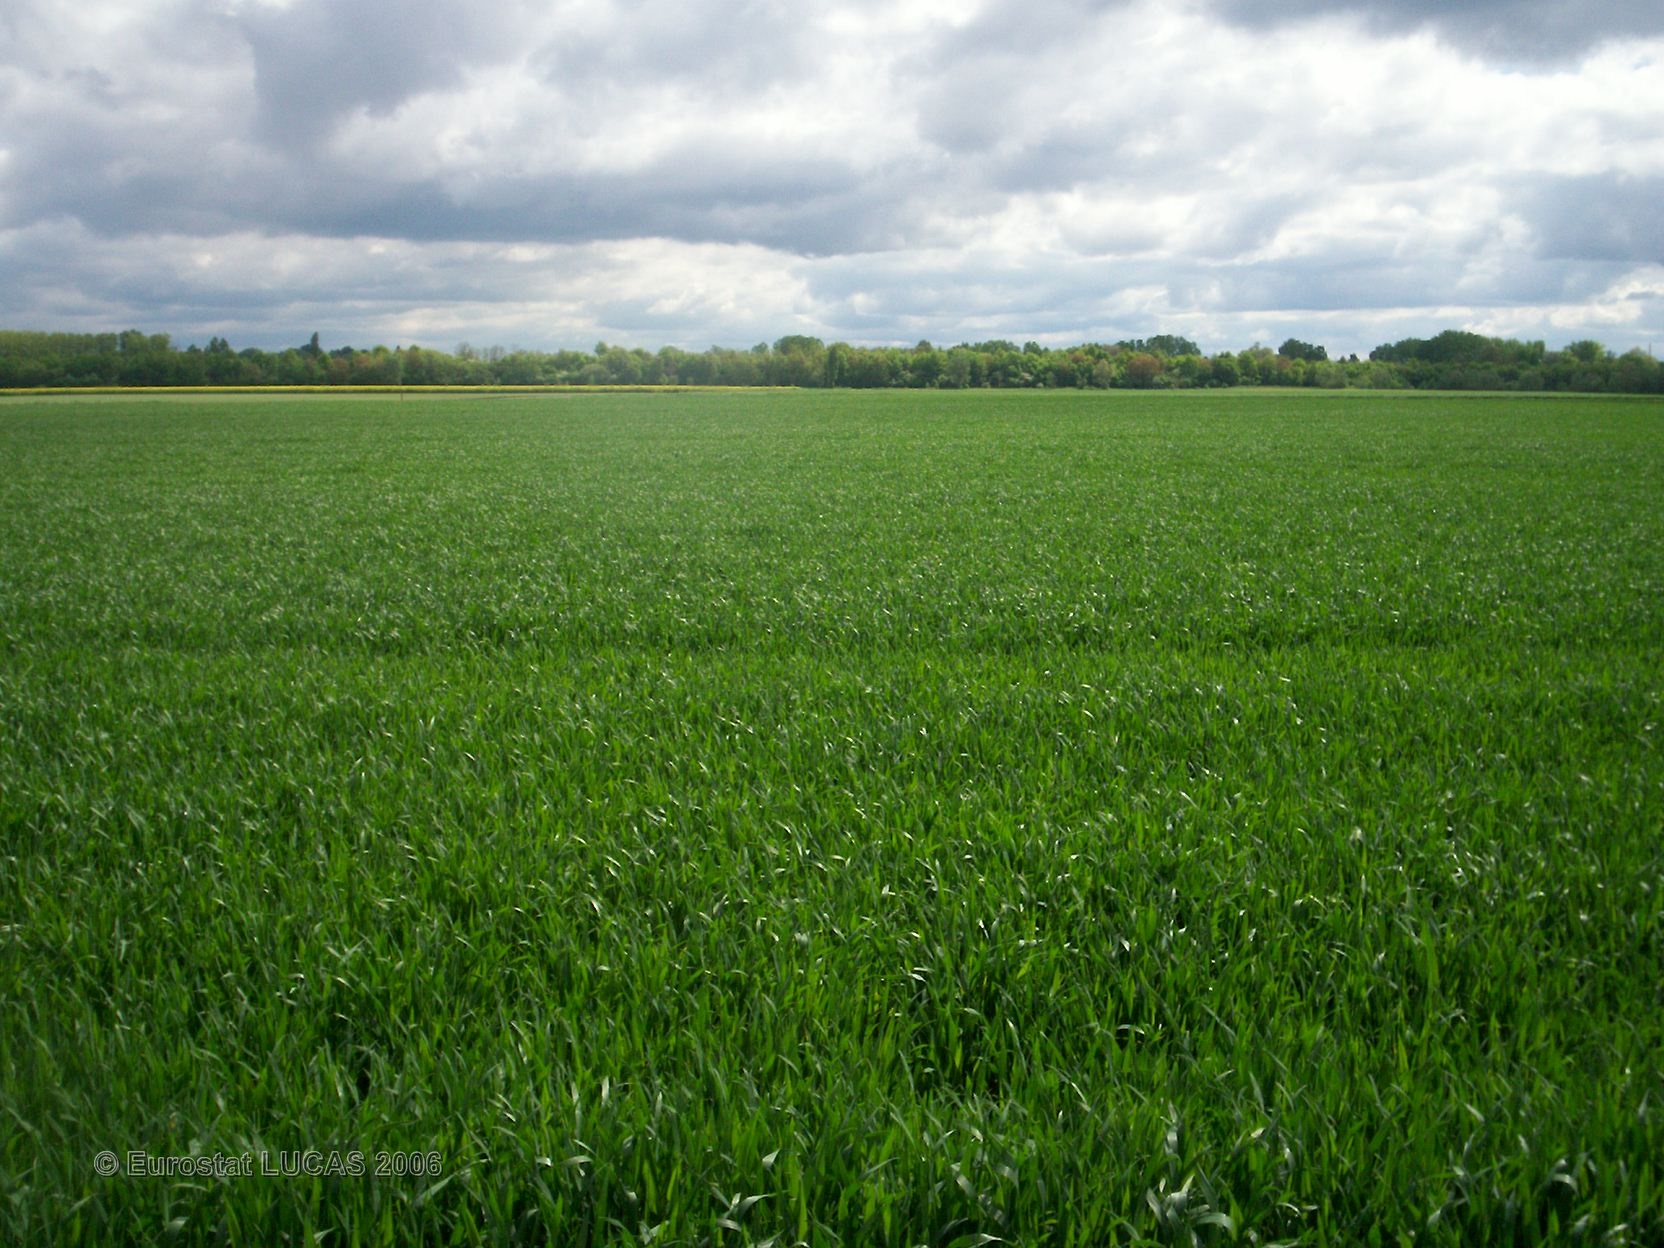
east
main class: Cropland
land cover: Common wheat
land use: Agriculture (excluding fallow land and kitchen gardens)
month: May
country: FR
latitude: 45.9507
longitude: 3.1489
